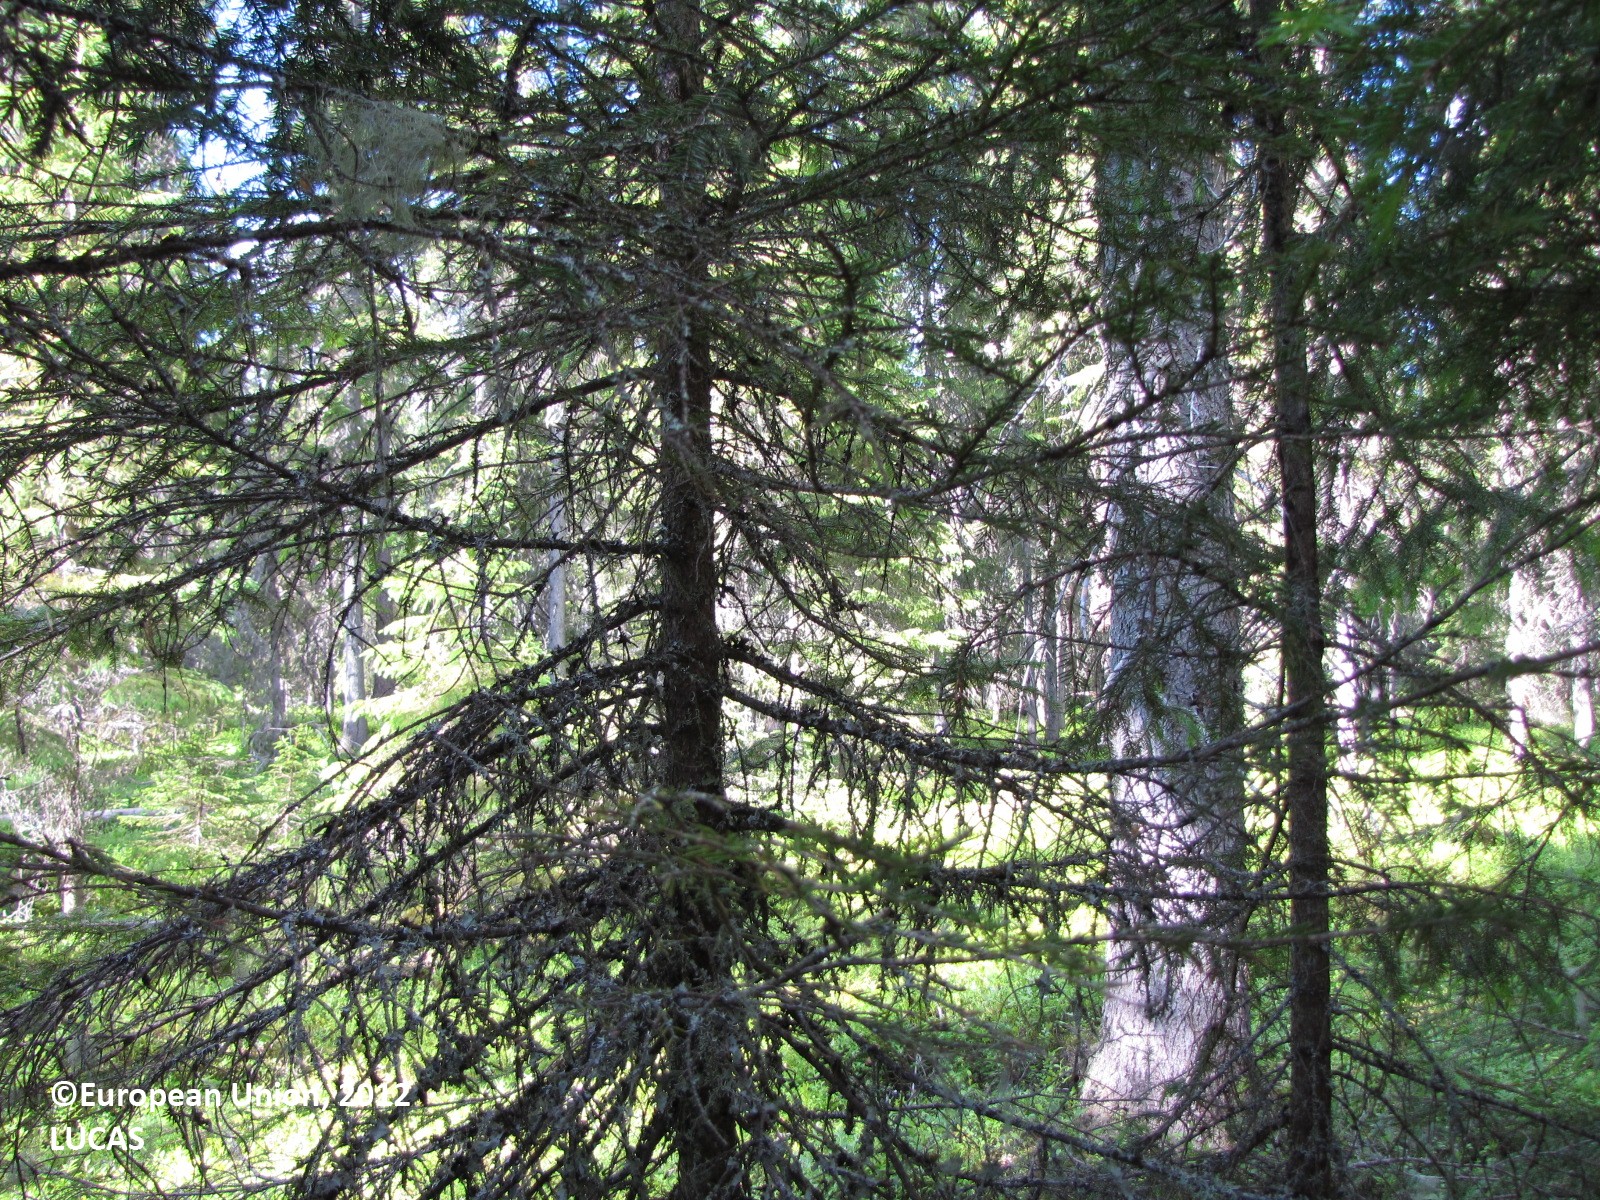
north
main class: Woodland
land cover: Spruce dominated coniferous woodland
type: boreal forest
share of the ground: 50 - 75 %
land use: Forestry
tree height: > 5 m
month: July
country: FI
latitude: 66.2728
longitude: 25.1373
